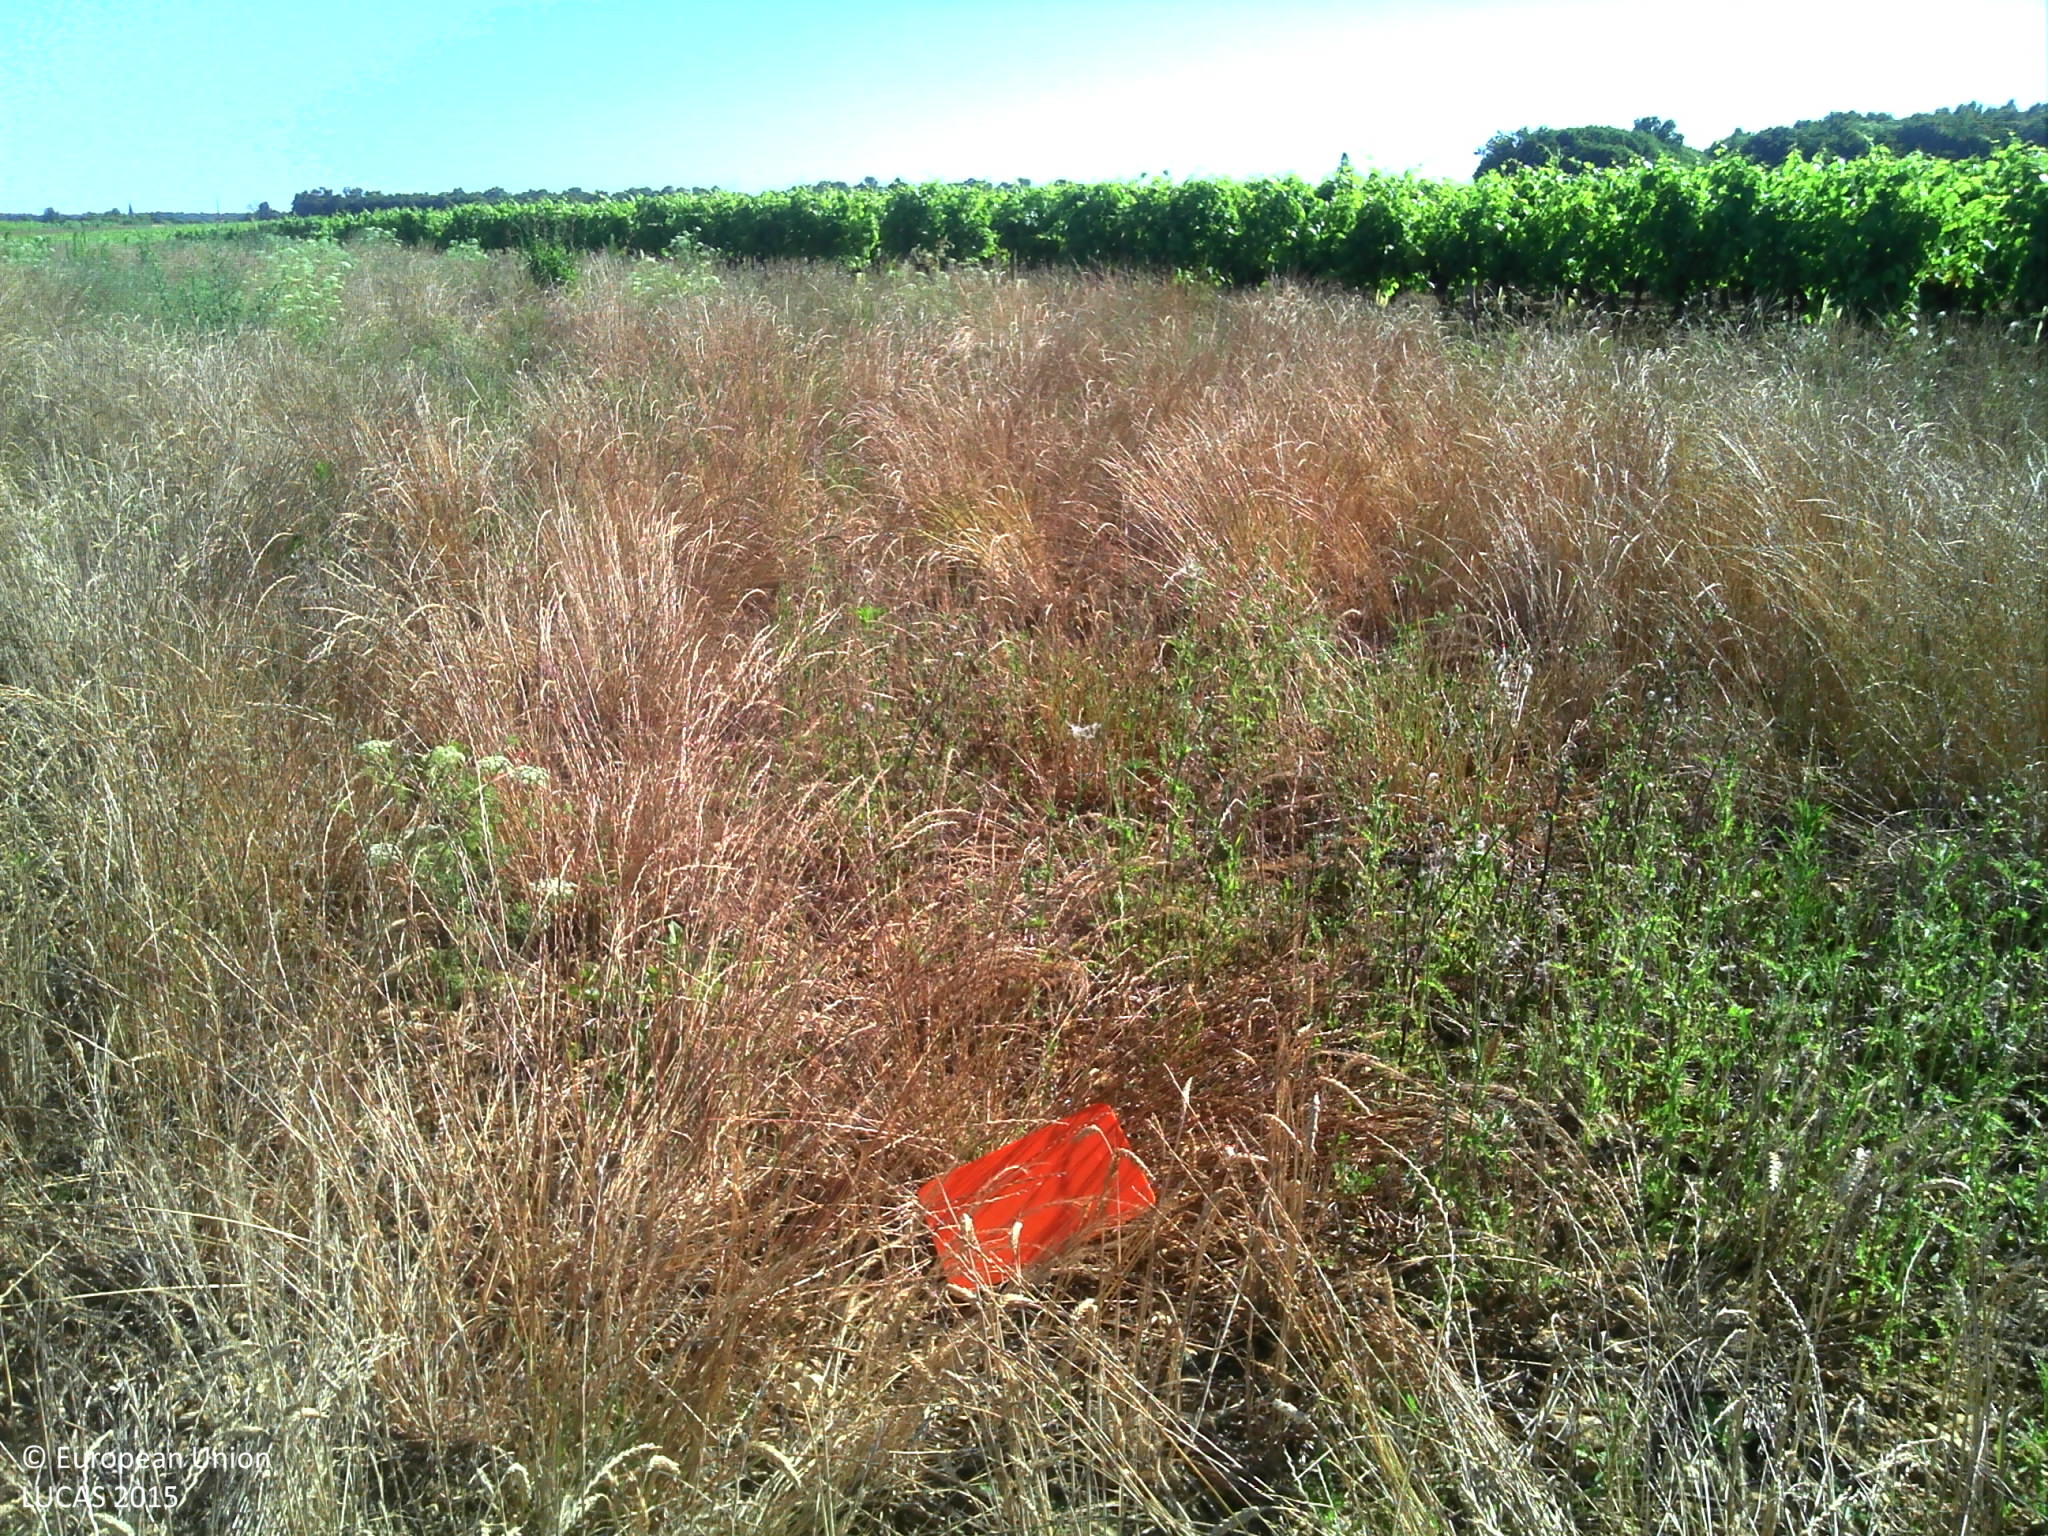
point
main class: Grassland
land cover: Spontaneously vegetated surfaces
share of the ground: > 75 %
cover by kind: herbaceous plants 100 %
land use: Agriculture (excluding fallow land and kitchen gardens)
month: June
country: FR
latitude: 45.5260
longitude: -0.6630
